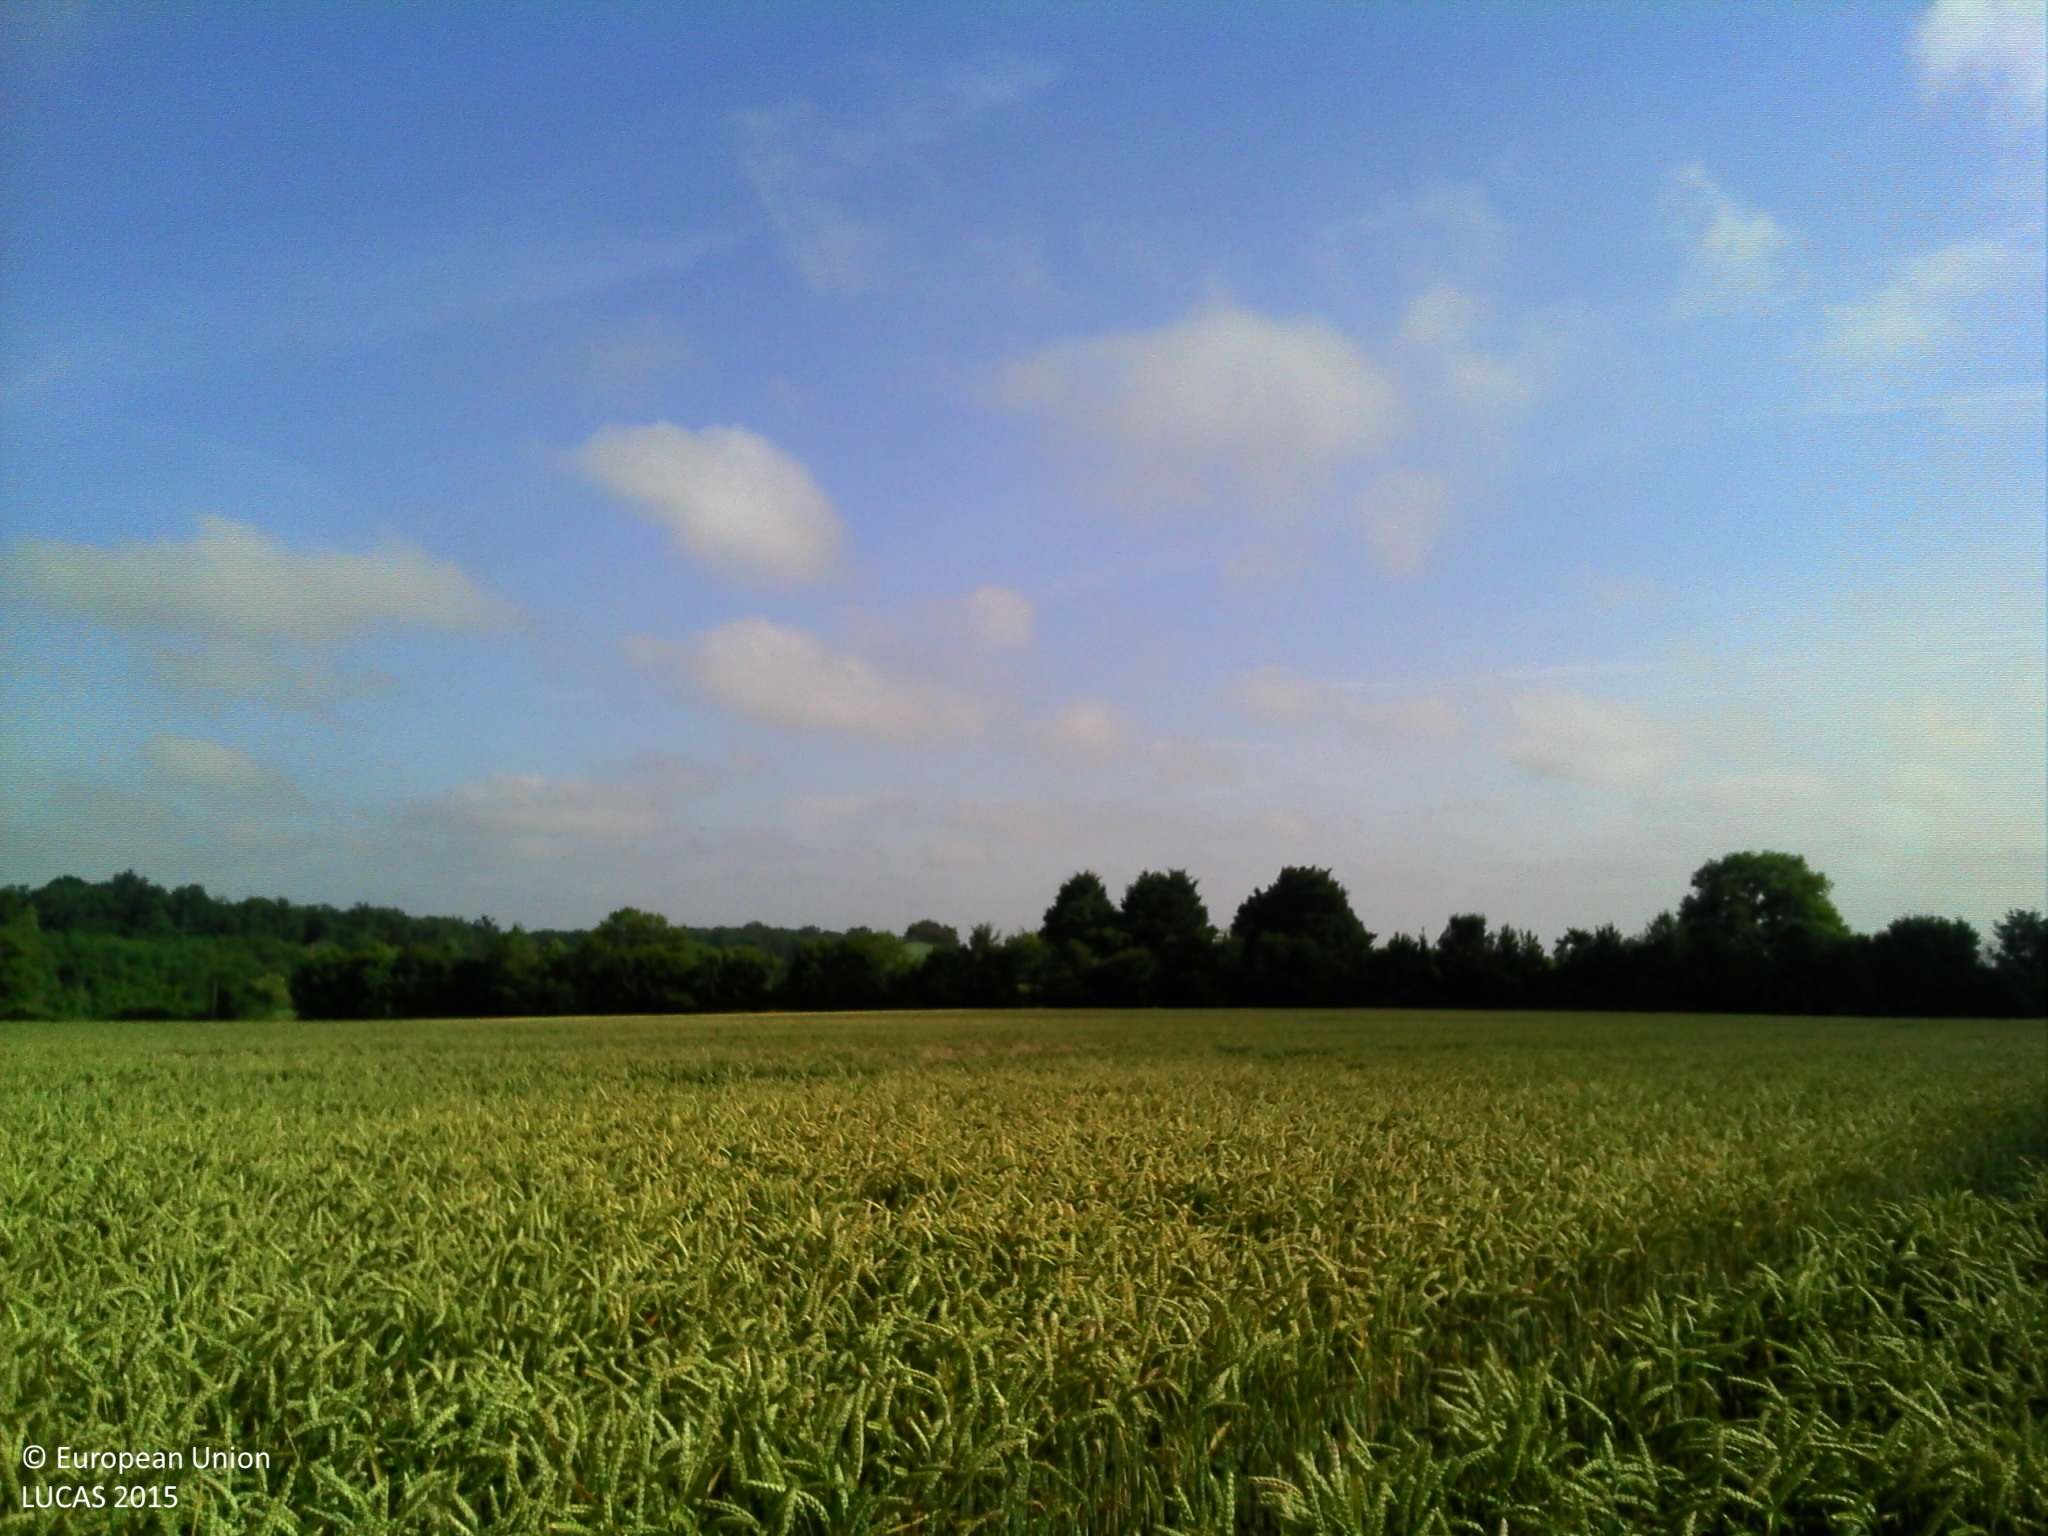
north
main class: Cropland
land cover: Common wheat
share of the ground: > 75 %
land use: Agriculture (excluding fallow land and kitchen gardens)
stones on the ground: < 10 %
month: June
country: FR
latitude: 48.2020
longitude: 0.1914
